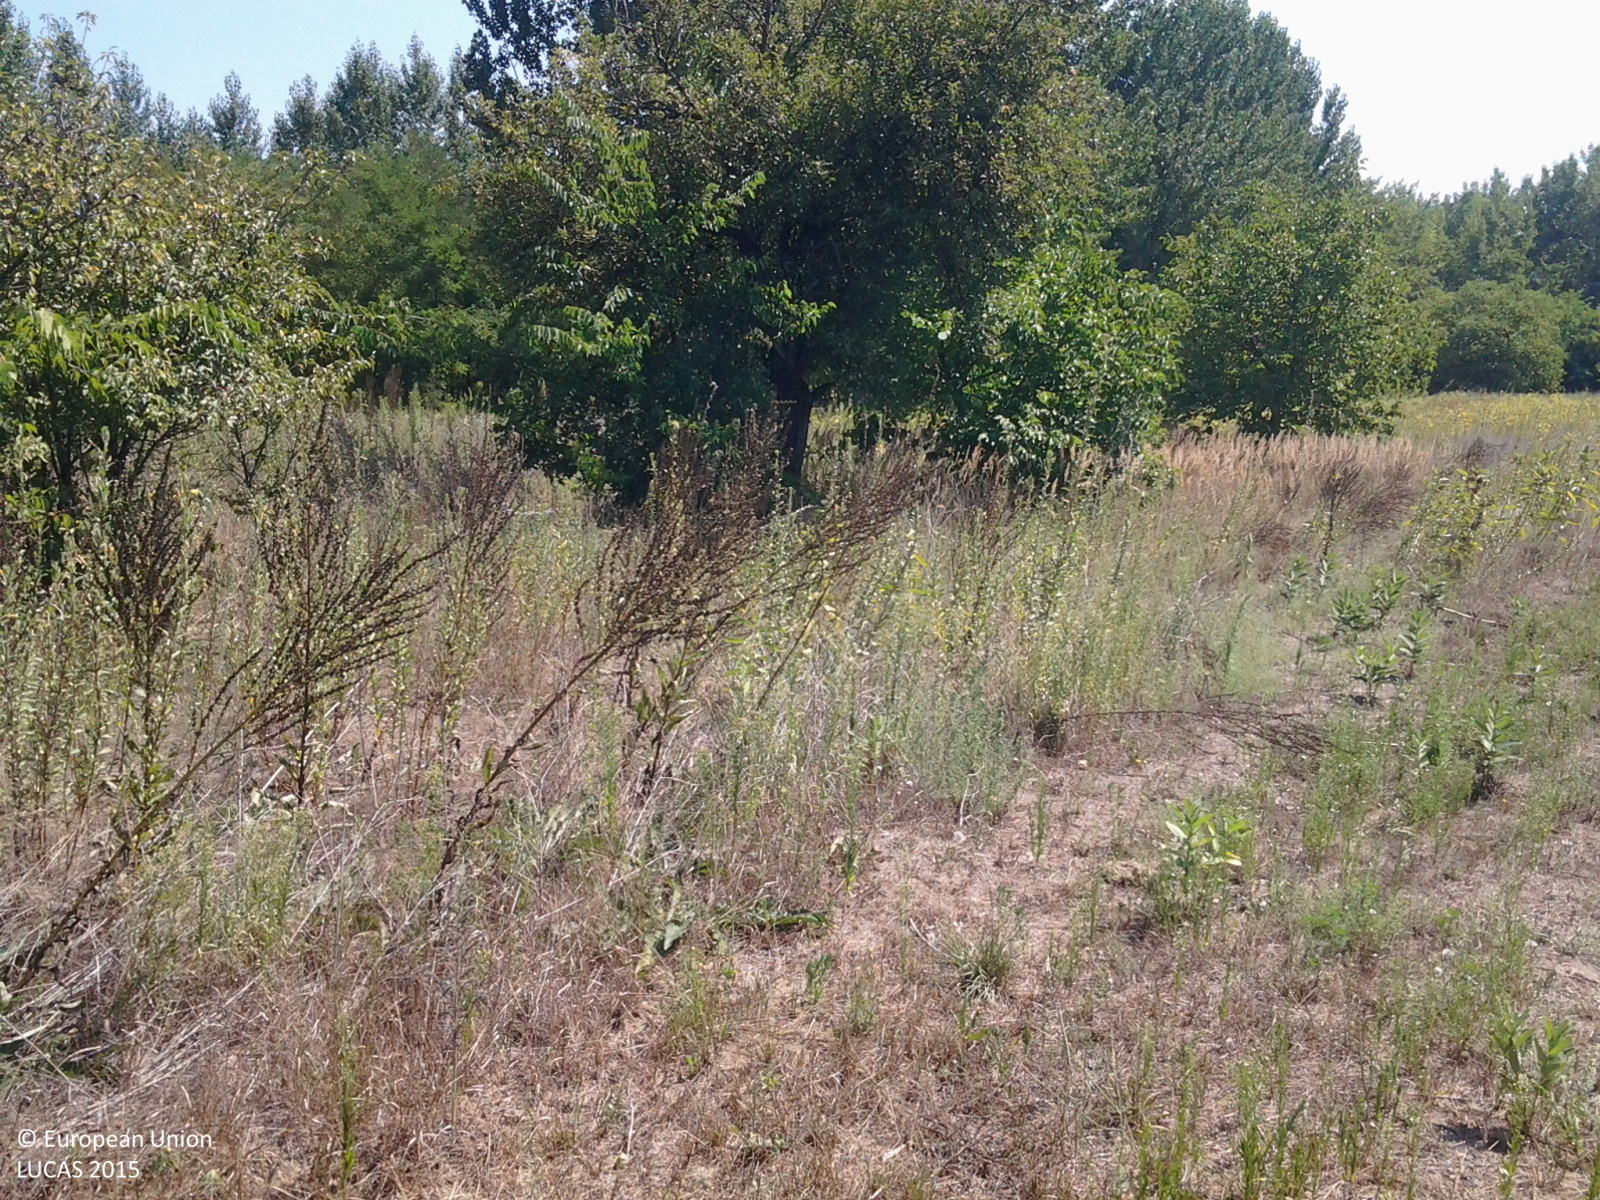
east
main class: Grassland
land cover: Spontaneously vegetated surfaces
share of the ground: > 75 %
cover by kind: herbaceous plants 100 %
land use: Fallow land
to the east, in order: Spontaneously vegetated surfaces; Other bare soil; Lines of trees; Other bare soil; Broadleaved woodland; Other bare soil; Broadleaved woodland
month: August
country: HU
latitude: 47.3349
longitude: 19.7766
